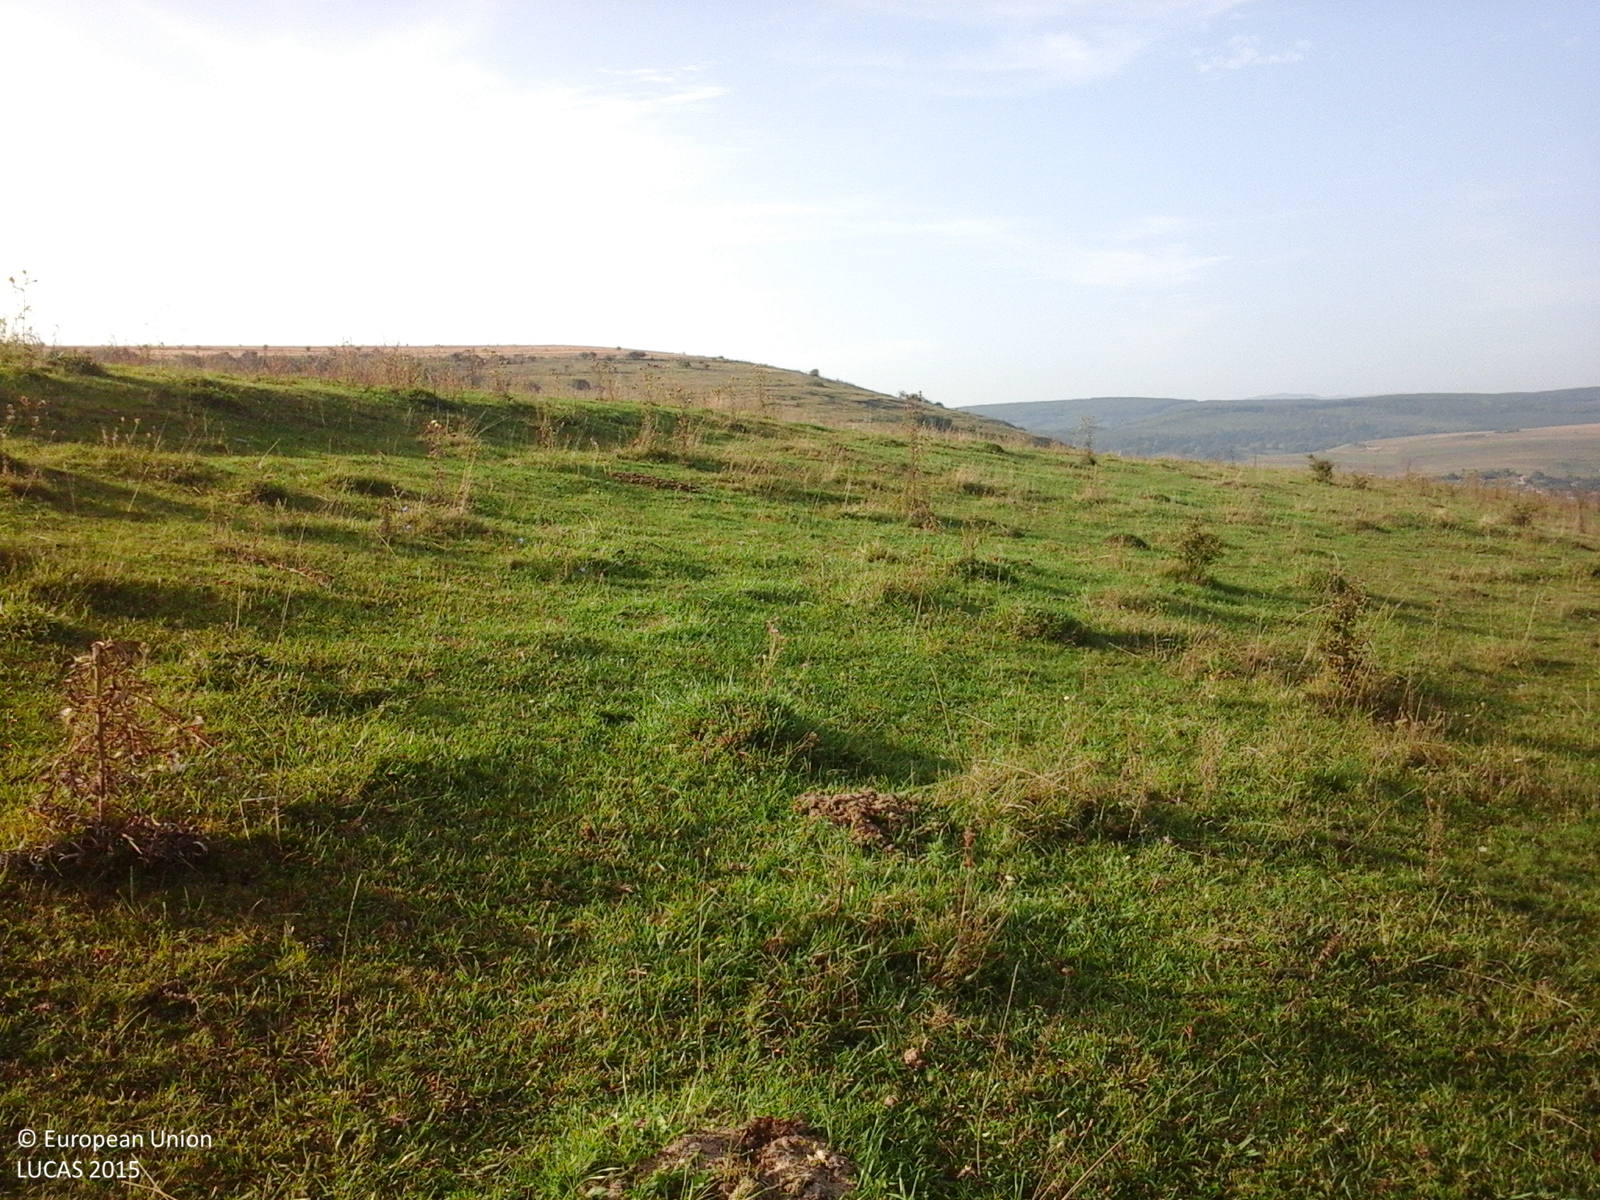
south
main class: Grassland
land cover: Grassland without tree/shrub cover
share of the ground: > 75 %
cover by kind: herbaceous plants 100 %
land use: Agriculture (excluding fallow land and kitchen gardens)
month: September
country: RO
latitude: 46.8384
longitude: 23.3761
